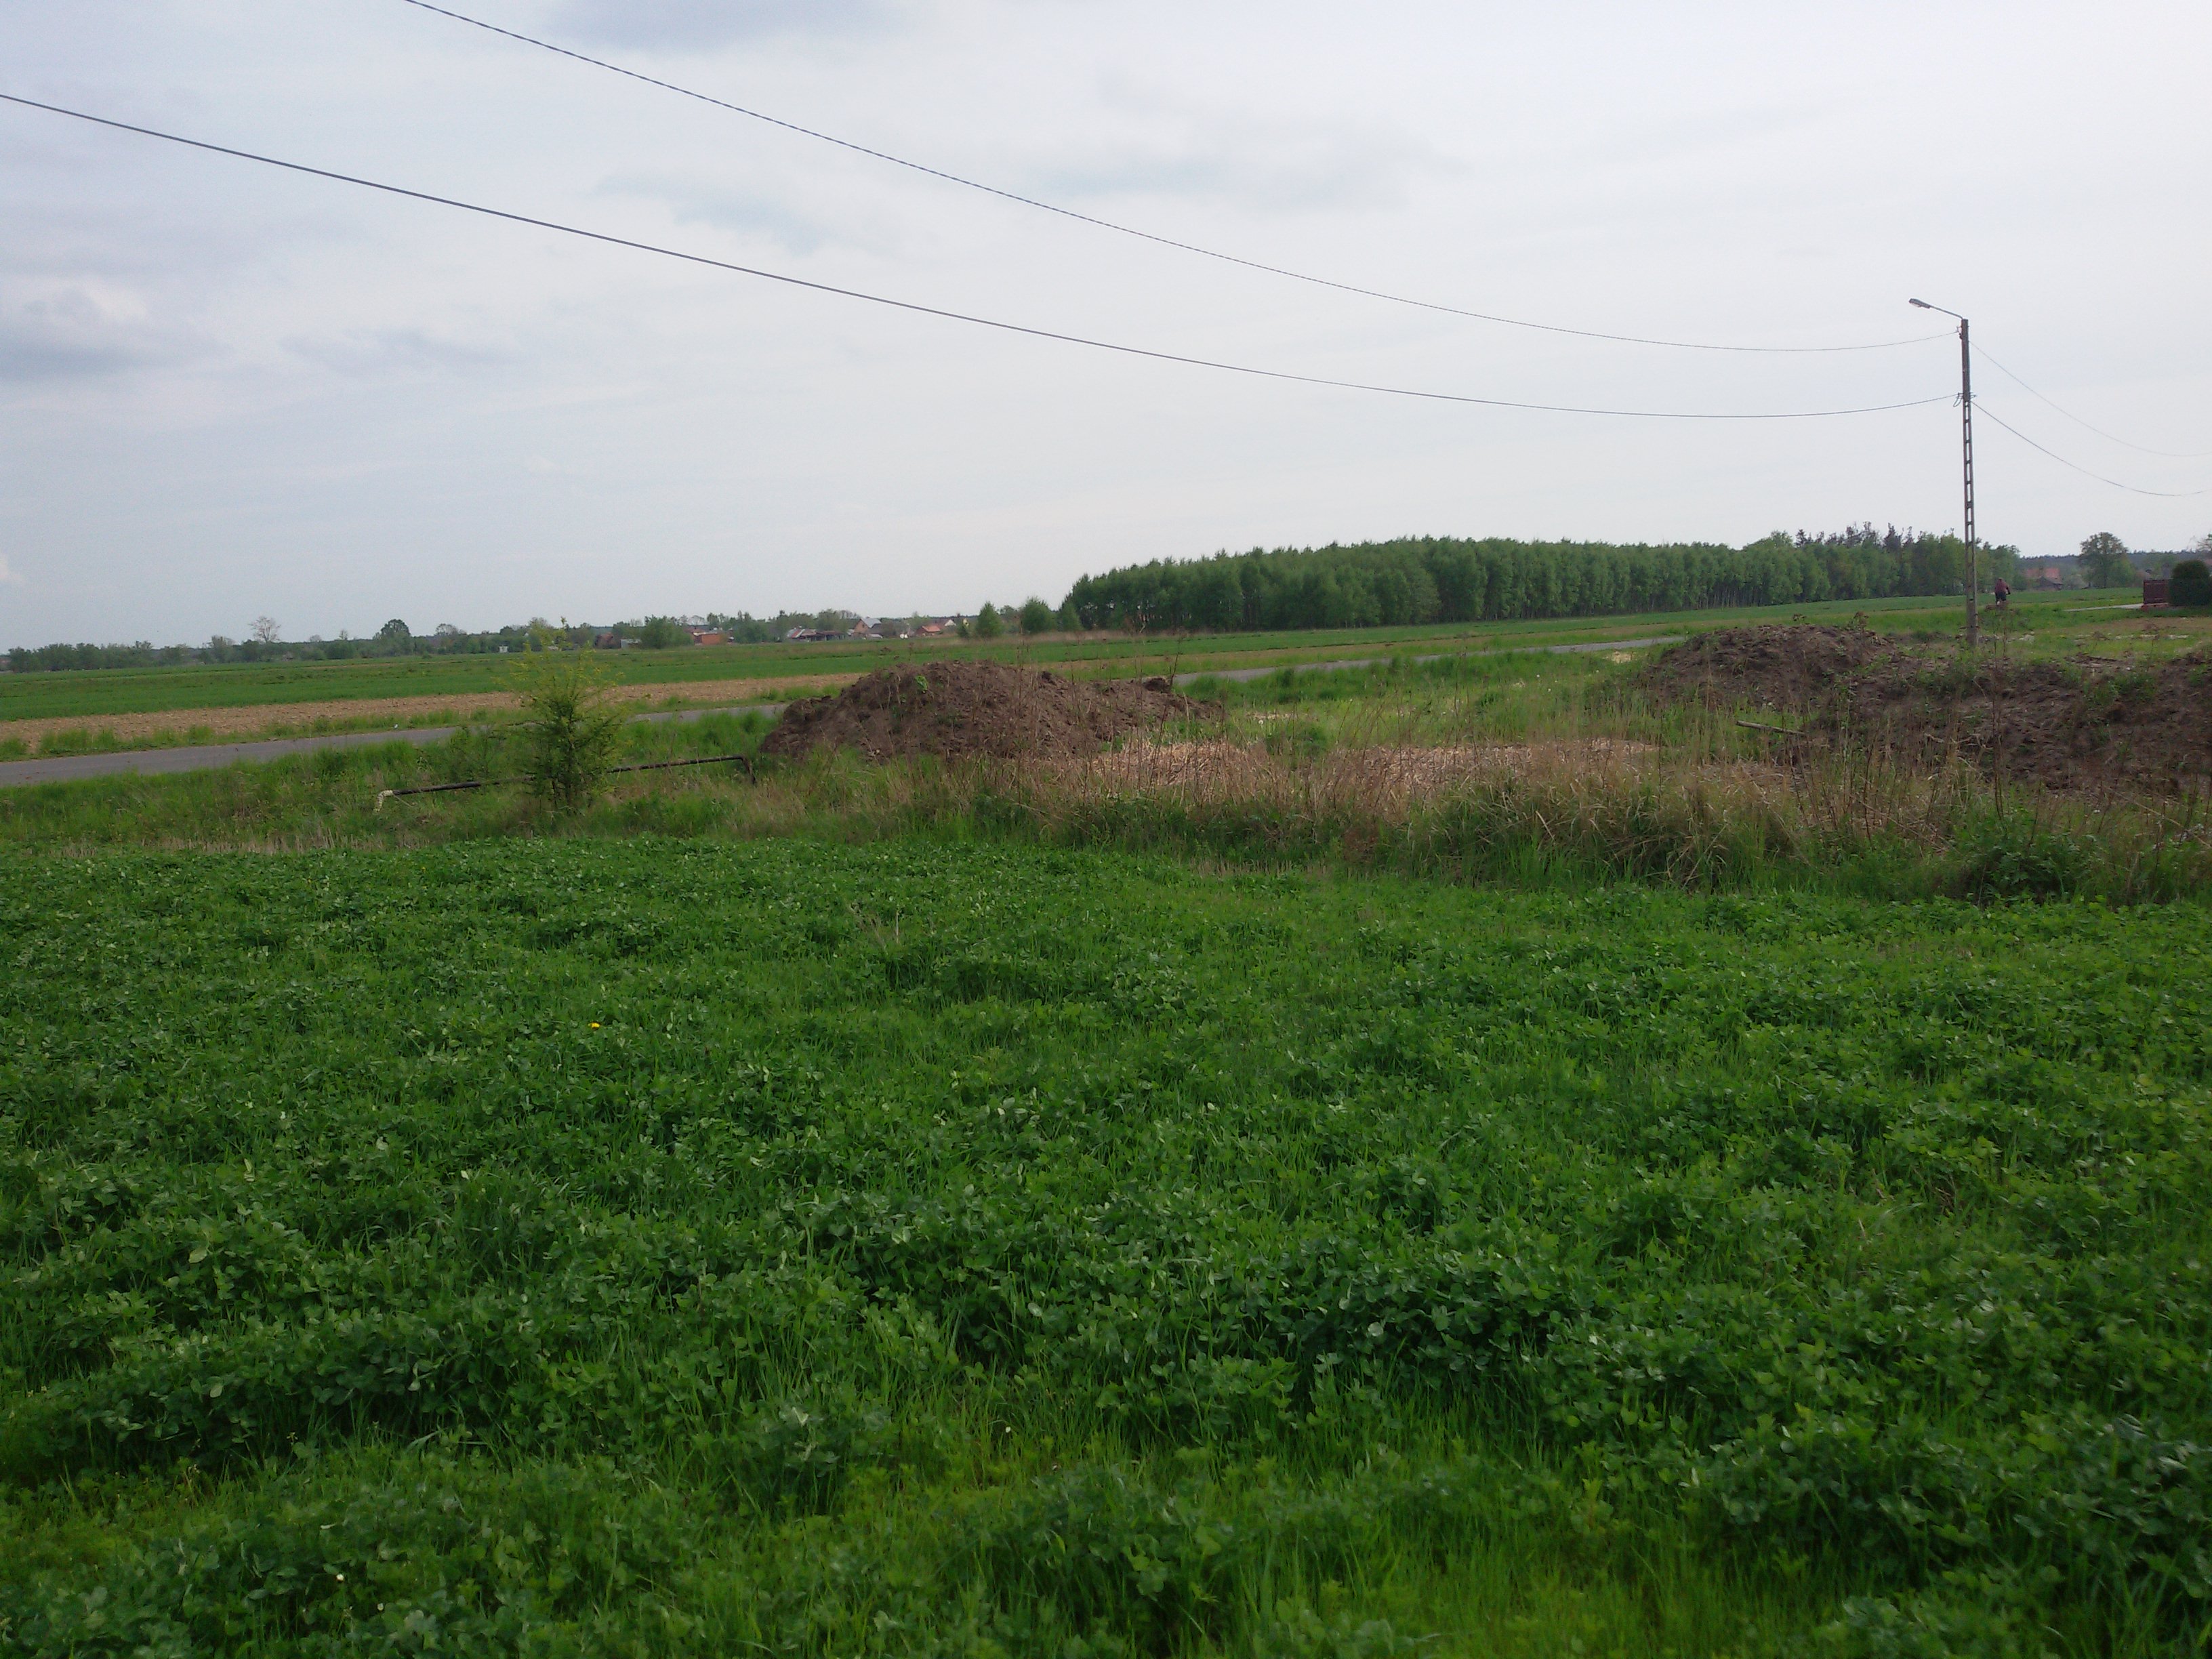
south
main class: Grassland
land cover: Grassland without tree/shrub cover
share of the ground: > 75 %
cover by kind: herbaceous plants 100 %
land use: Agriculture (excluding fallow land and kitchen gardens)
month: May
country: PL
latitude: 50.3055
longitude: 21.3511
